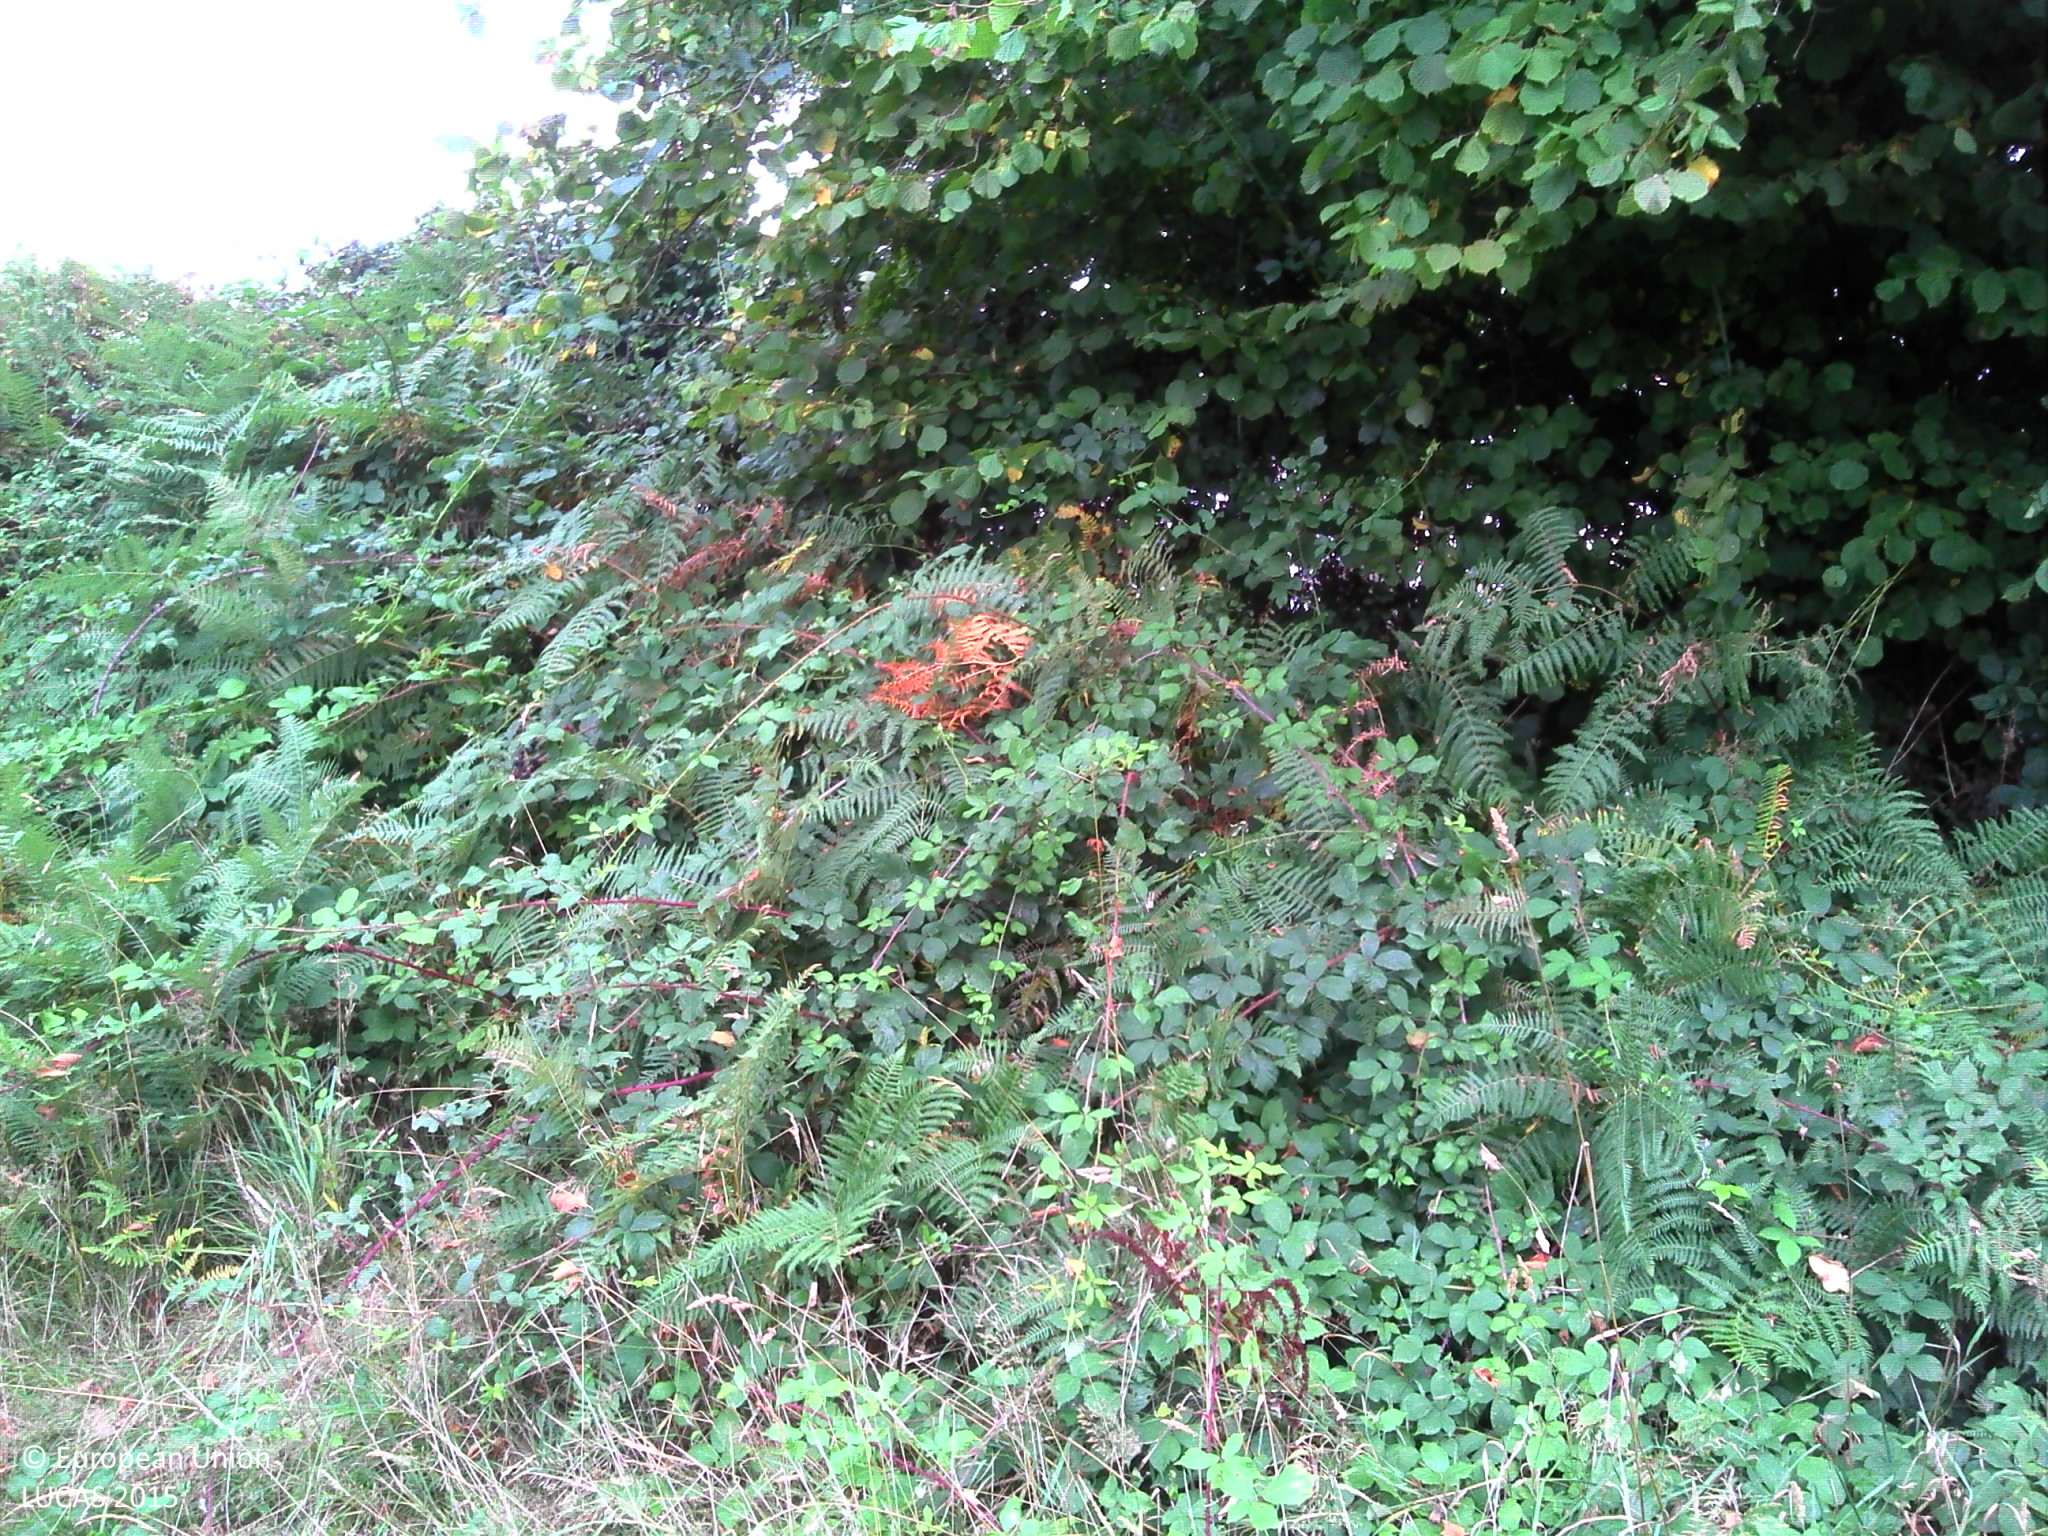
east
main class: Grassland
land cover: Spontaneously vegetated surfaces
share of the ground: > 75 %
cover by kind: herbaceous plants 95 %, shrubs 5 %
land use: Abandoned areas
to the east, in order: Spontaneously vegetated surfaces; Shrubland with sparse tree cover; Fences; Barley; Fences; Broadleaved woodland; Tracks; Broadleaved woodland; Common wheat
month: August
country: FR
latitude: 47.5635
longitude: -1.5136
